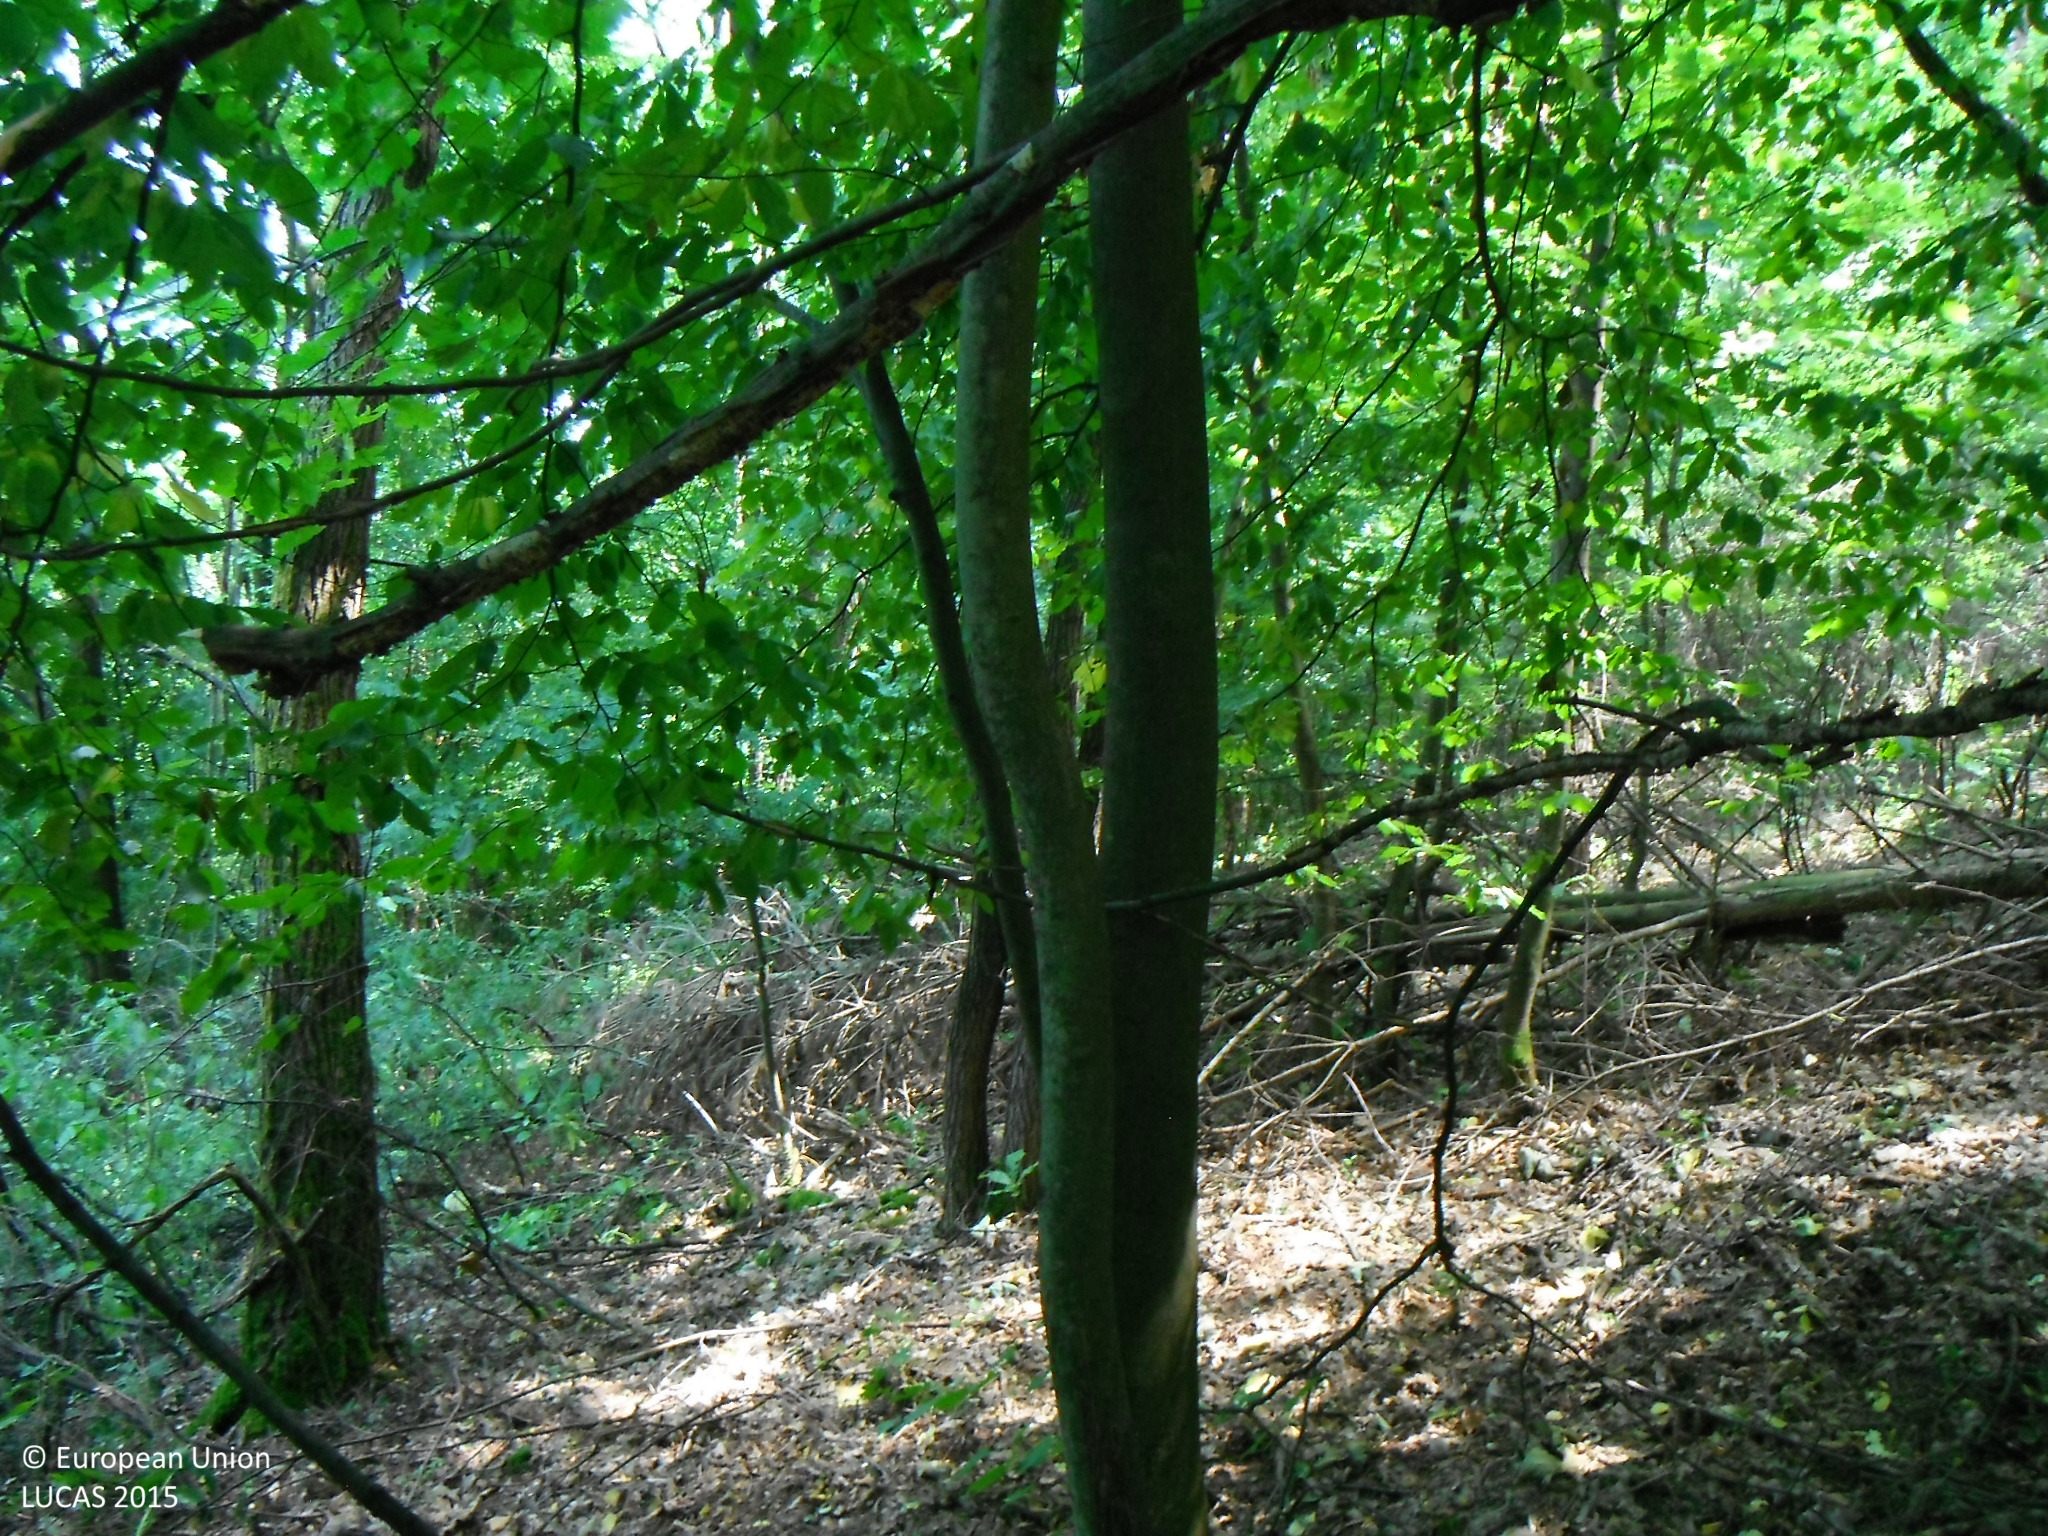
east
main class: Woodland
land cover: Broadleaved woodland
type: mesophytic deciduous forest
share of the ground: > 75 %
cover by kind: broadleaved forest trees 100 %
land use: Forestry
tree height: > 5 m
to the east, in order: Broadleaved woodland; Pine dominated mixed woodland; Broadleaved woodland; Rivers and streams; Broadleaved woodland; Grassland without tree/shrub cover
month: July
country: SK
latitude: 48.2005
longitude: 20.0257
